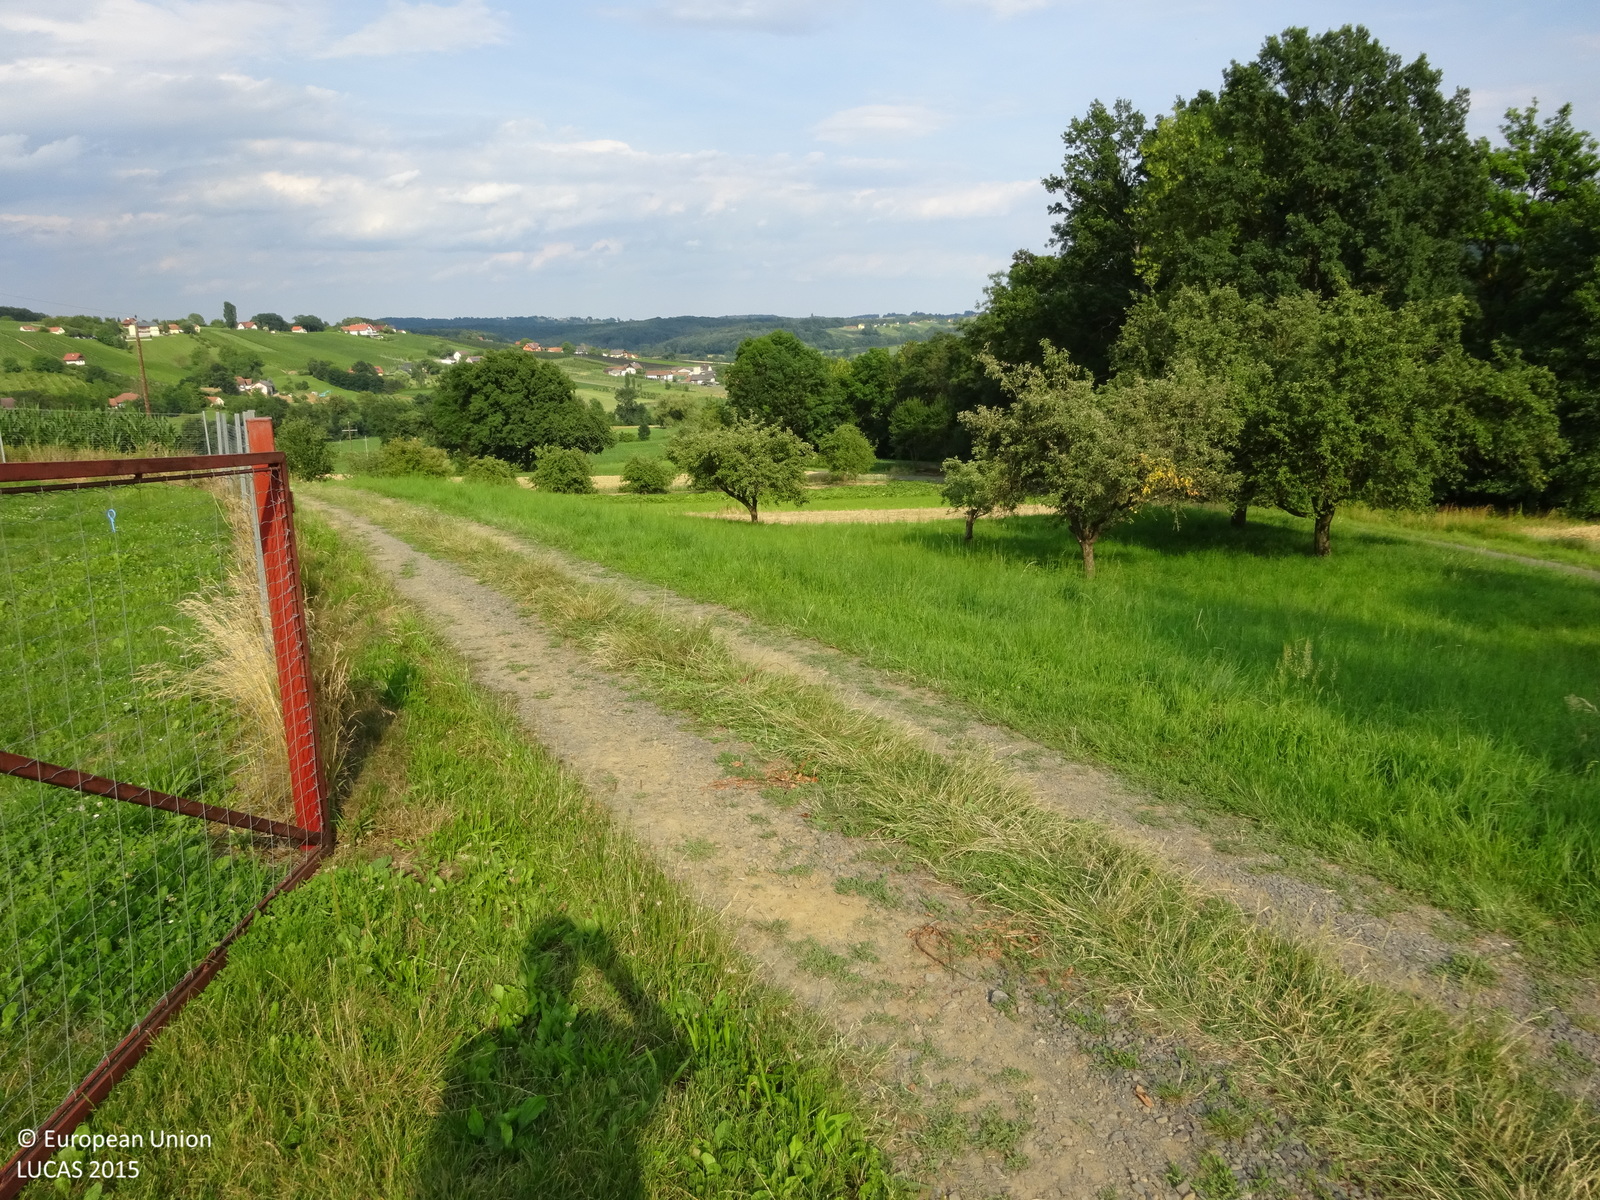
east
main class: Cropland
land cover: Apple fruit
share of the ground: > 75 %
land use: Agriculture (excluding fallow land and kitchen gardens)
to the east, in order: Grass margins; Apple fruit; Fences; Grass margins; Maize; Grass margins; Other root crops; Maize; Grass margins; Other root crops; Maize; Fences; Nurseries; Fences; Tracks; Maize
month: June
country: AT
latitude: 46.8003
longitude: 15.9358
